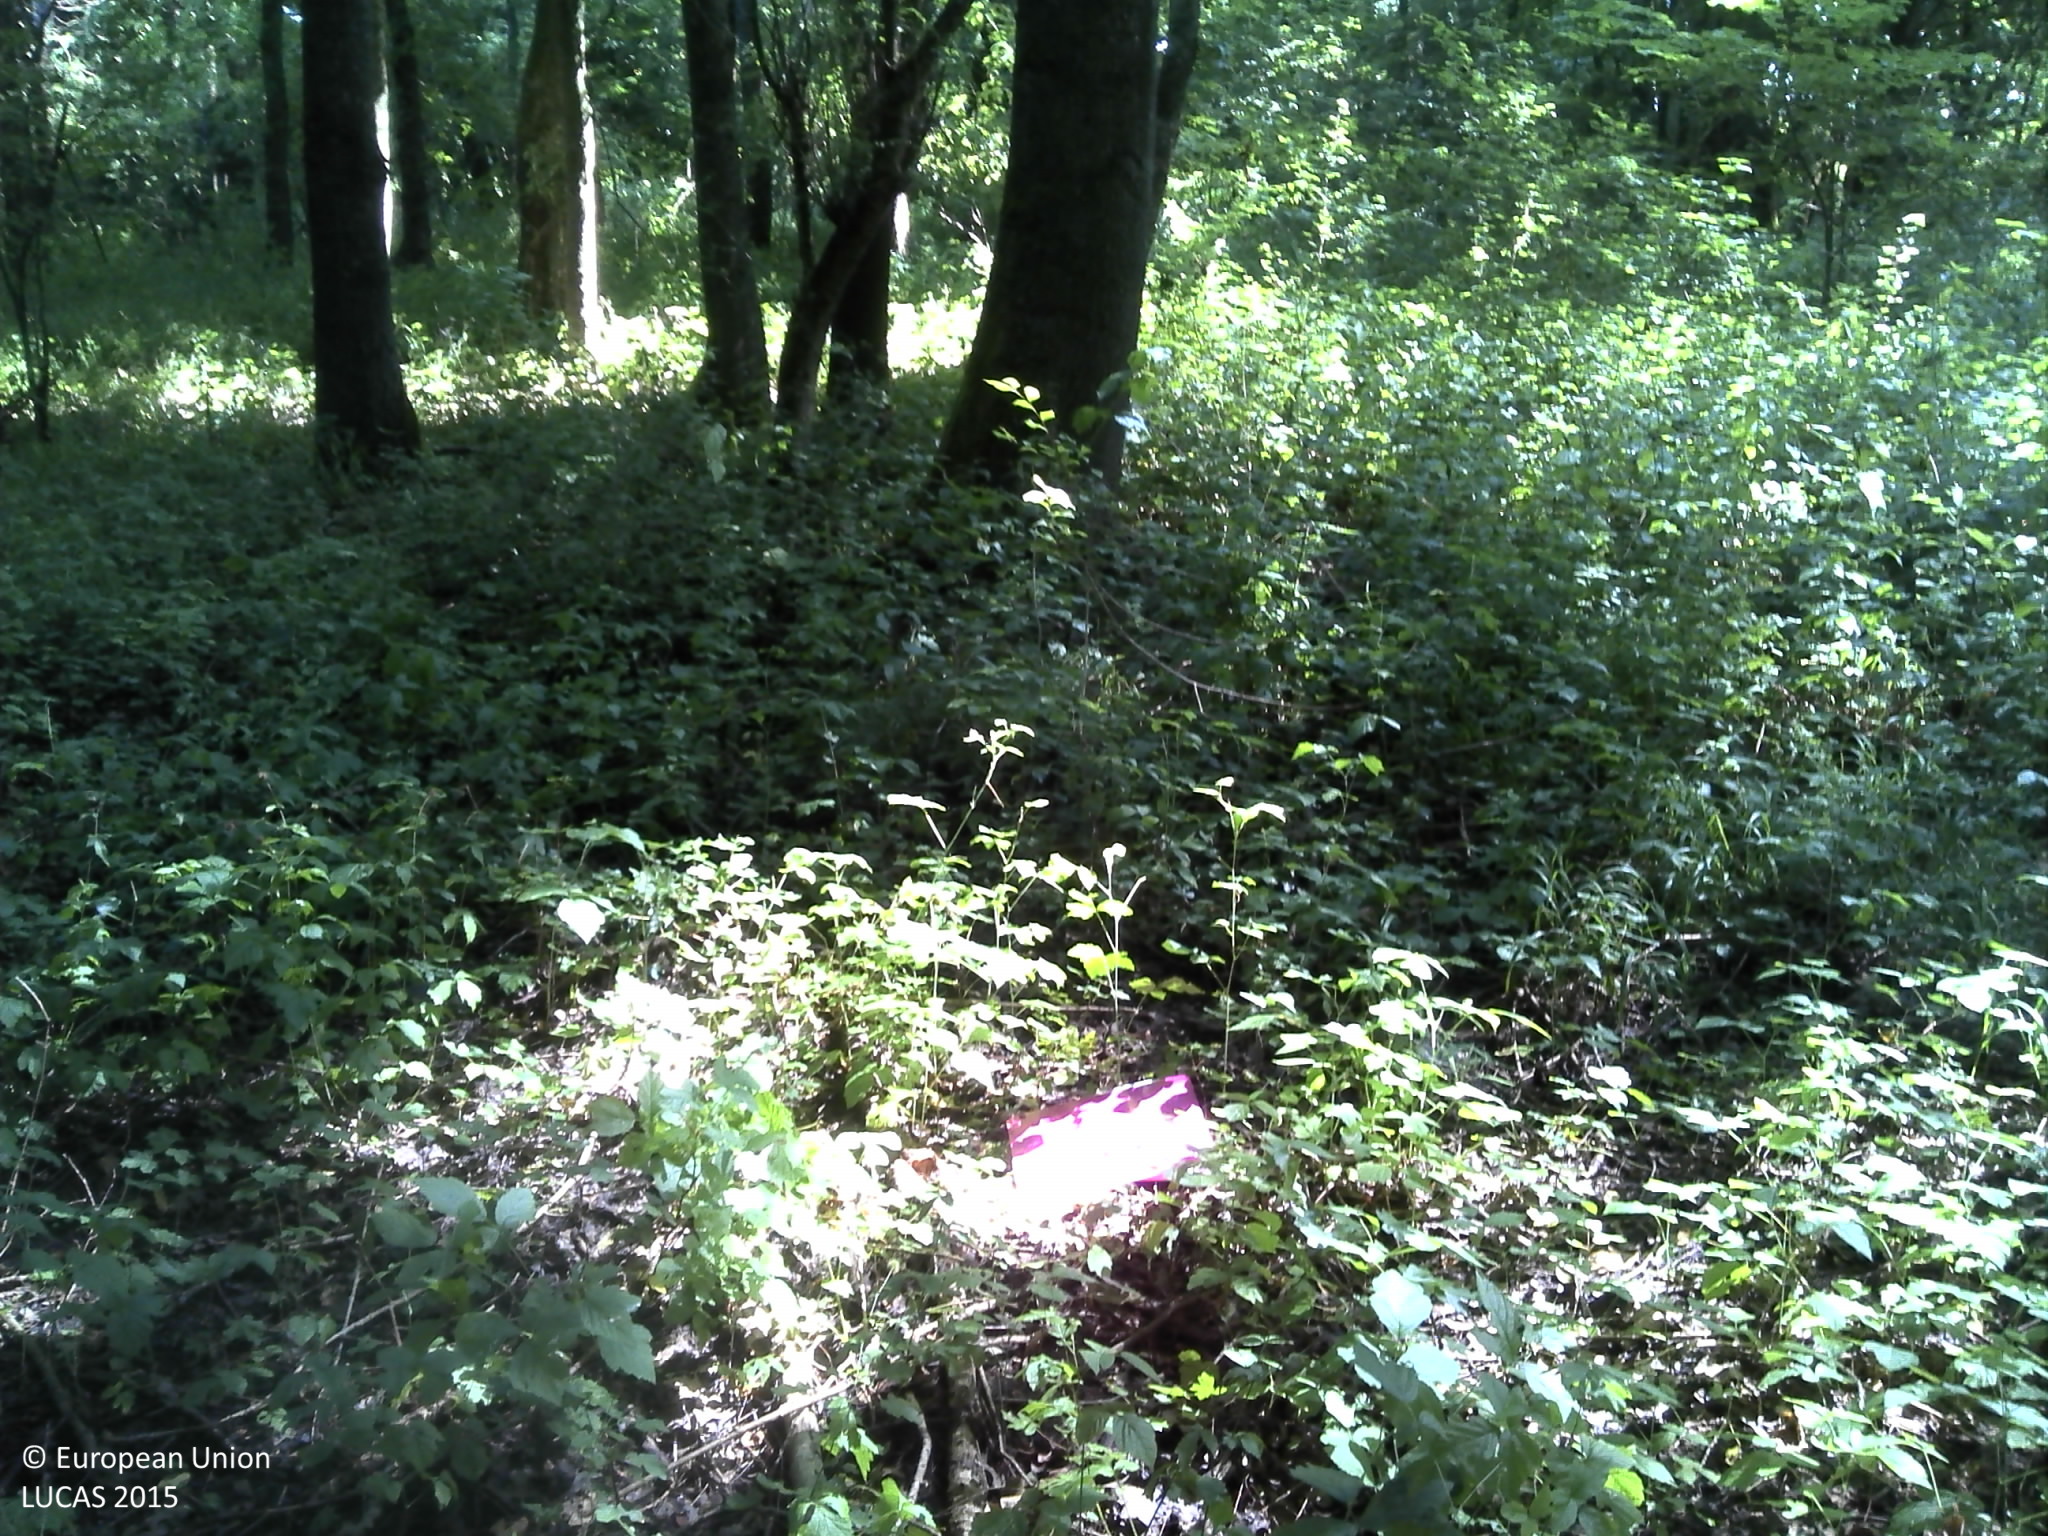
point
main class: Woodland
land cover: Broadleaved woodland
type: mesophytic deciduous forest
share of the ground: > 75 %
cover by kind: broadleaved forest trees 90 %, shrubs 5 %, herbaceous plants 5 %
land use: Forestry
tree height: > 5 m
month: July
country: HR
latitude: 45.8219
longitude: 16.8864
